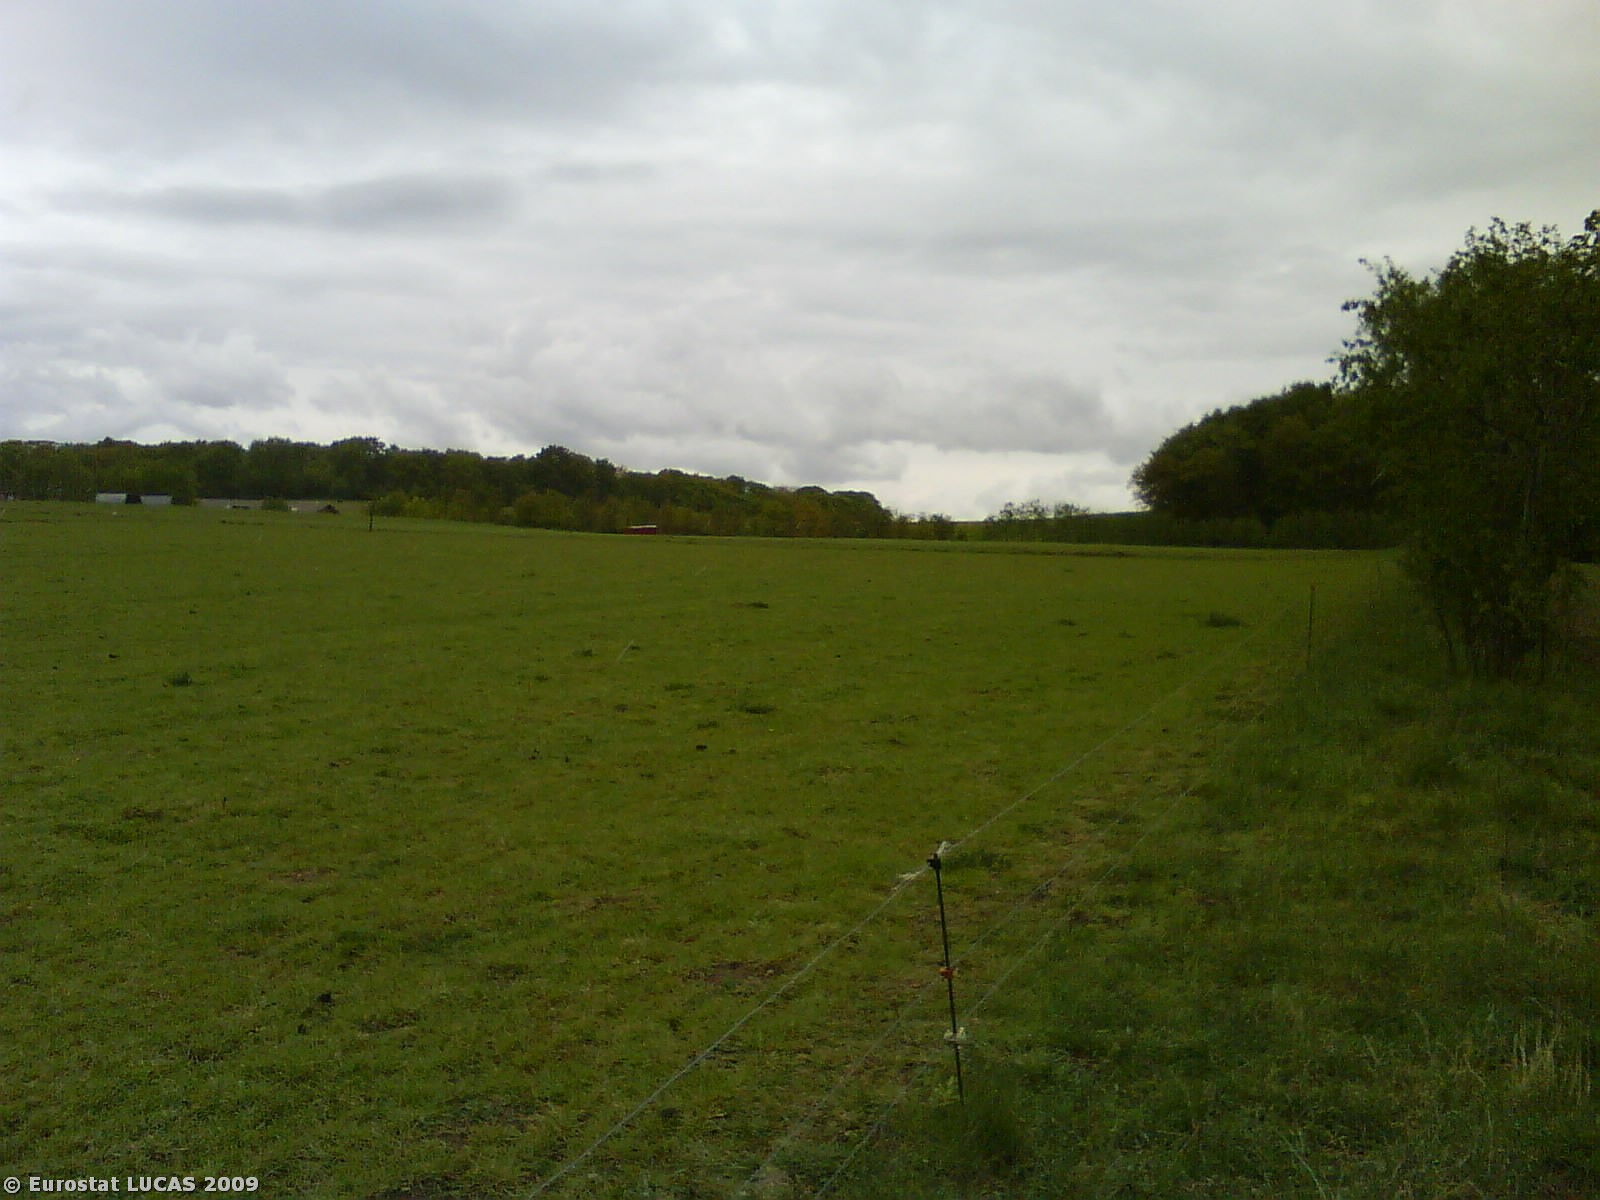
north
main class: Grassland
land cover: Grassland without tree/shrub cover
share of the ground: > 75 %
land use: Agriculture (excluding fallow land and kitchen gardens)
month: May
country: DK
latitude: 56.4034
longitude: 10.1133
